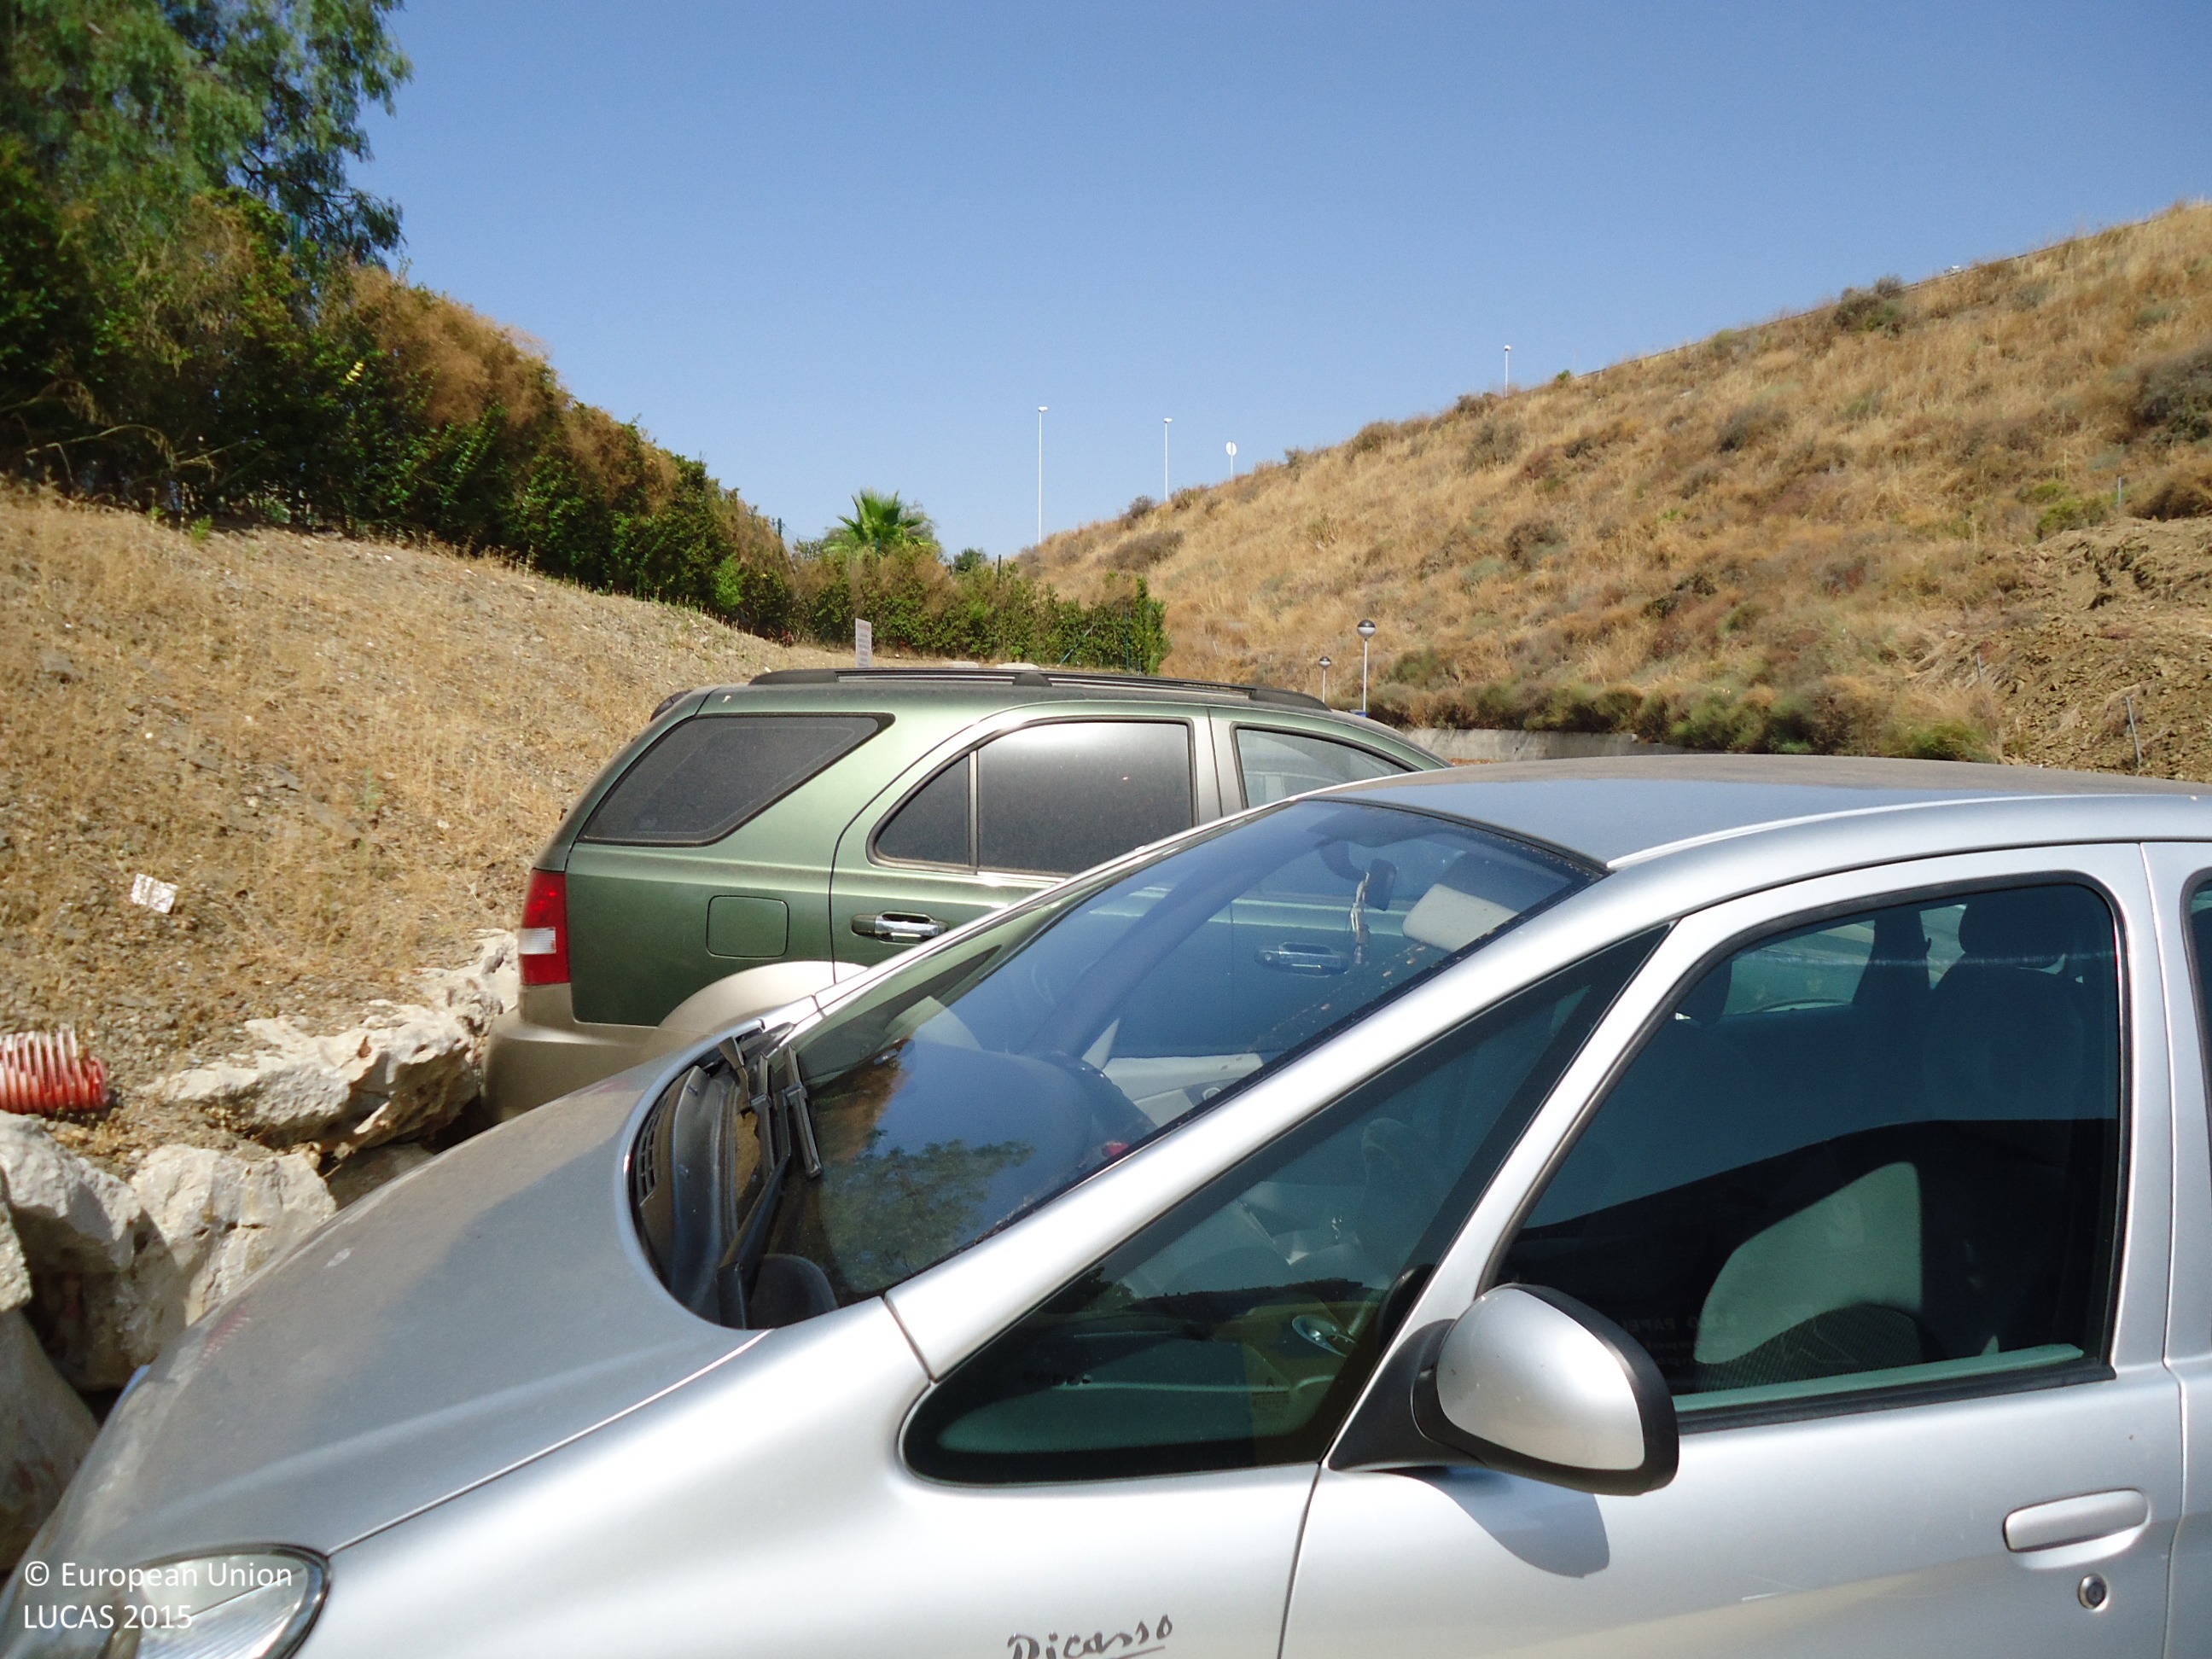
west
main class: Grassland
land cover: Grassland with sparse tree/shrub cover
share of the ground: > 75 %
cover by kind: herbaceous plants 95 %, broadleaved forest trees 5 %
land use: Residential
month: July
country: ES
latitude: 36.5039
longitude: -4.7157
